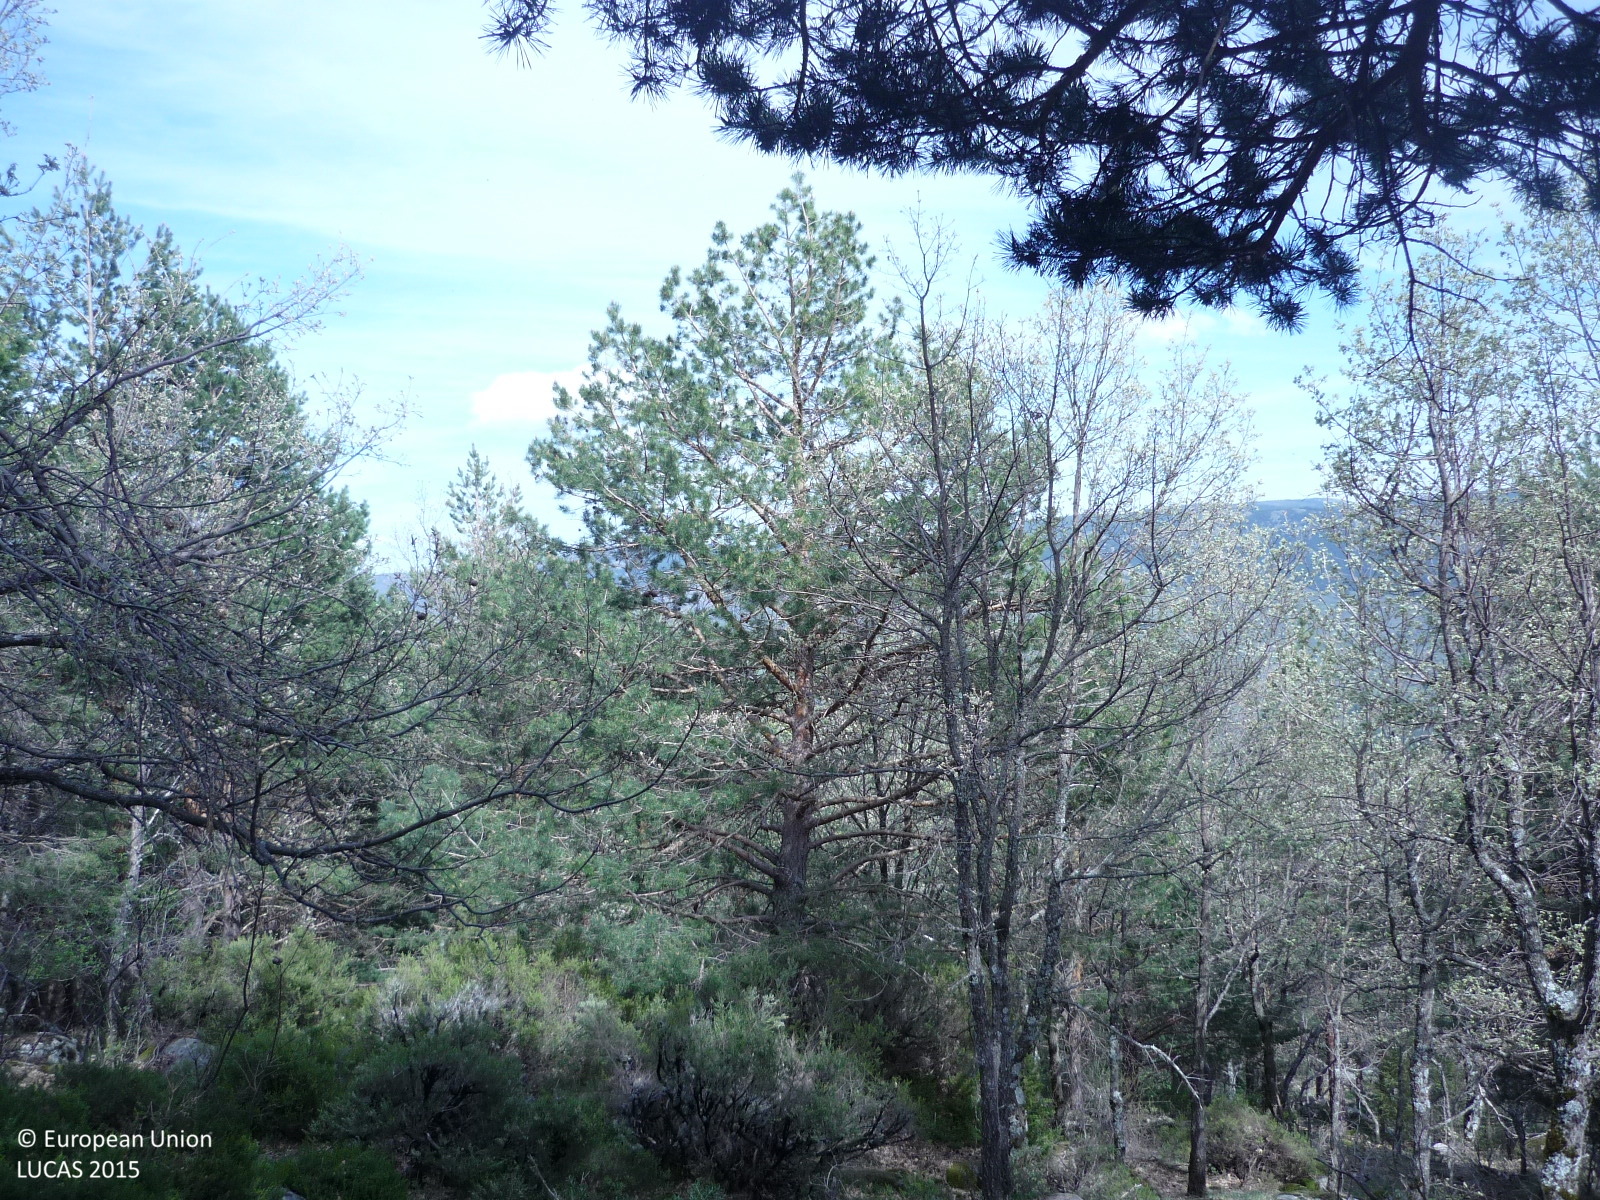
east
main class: Woodland
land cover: Pine dominated coniferous woodland
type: coniferous forest of the mediterranean region
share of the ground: > 75 %
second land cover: Grassland without tree/shrub cover
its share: 25 - 50 %
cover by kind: coniferous forest trees 85 %, shrubs 10 %, herbaceous plants 5 %
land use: Forestry
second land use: Agriculture (excluding fallow land and kitchen gardens)
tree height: > 5 m
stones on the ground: < 10 %
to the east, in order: Pine dominated coniferous woodland; Grassland without tree/shrub cover; Tracks; Pine dominated coniferous woodland; Rock outcrops; Pine dominated coniferous woodland; Rock outcrops; Pine dominated coniferous woodland
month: May
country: ES
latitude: 40.8821
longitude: -3.9195
